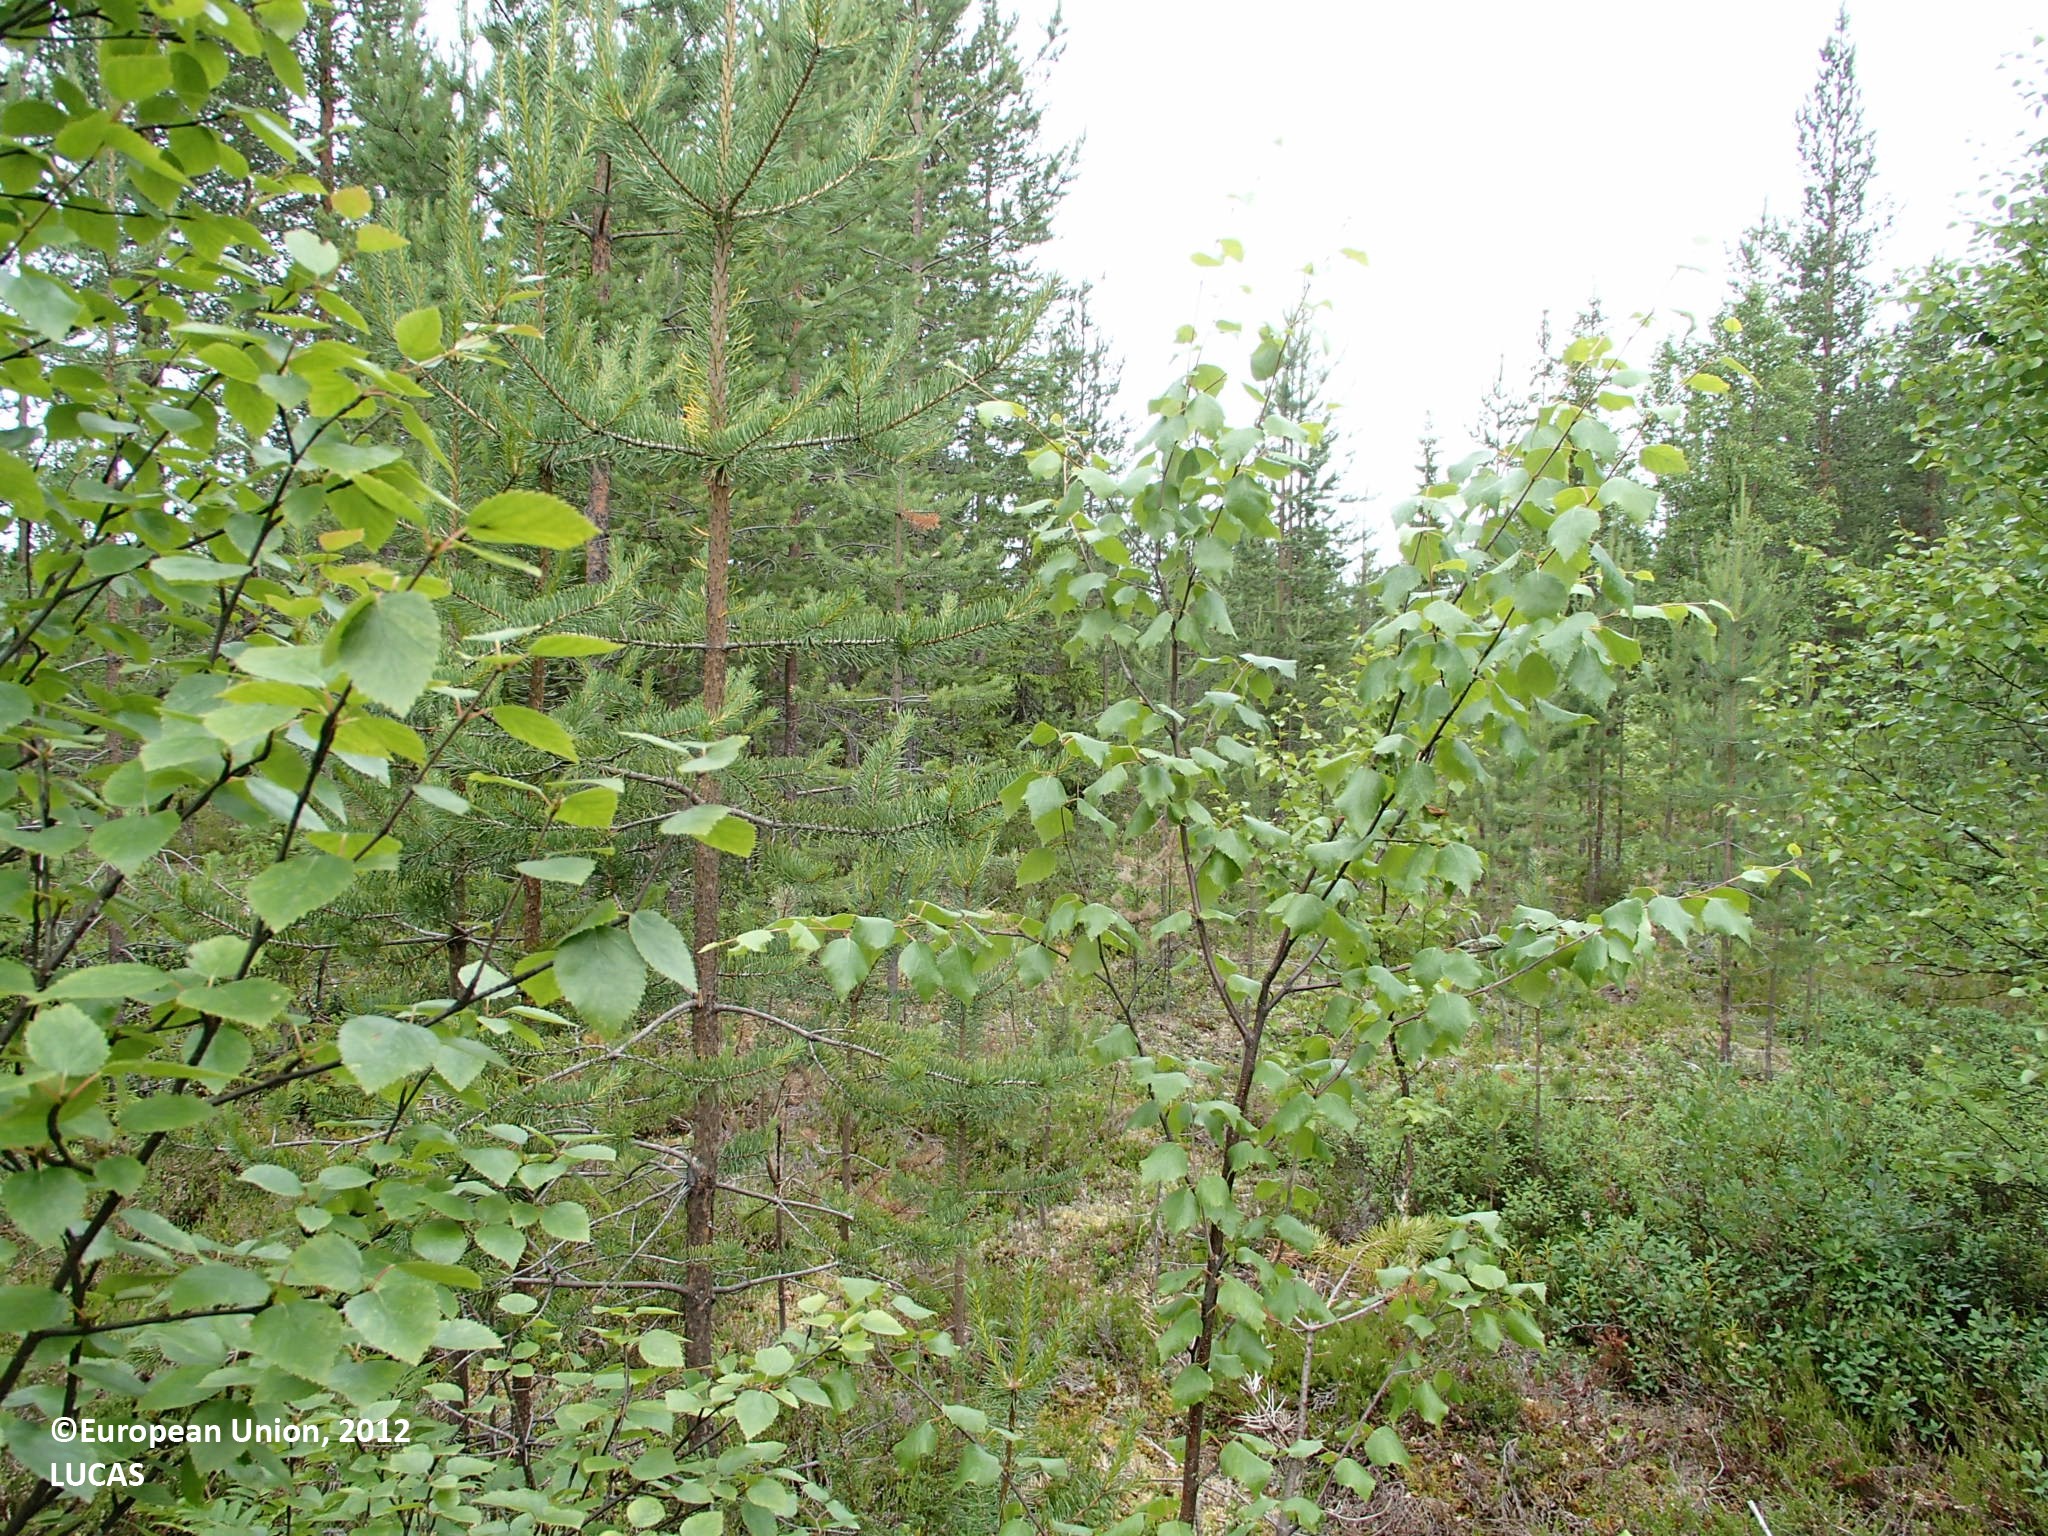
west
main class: Woodland
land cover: Other mixed woodland
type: boreal forest
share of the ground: 50 - 75 %
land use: Forestry
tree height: > 5 m
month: July
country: FI
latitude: 66.9170
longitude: 25.3925
